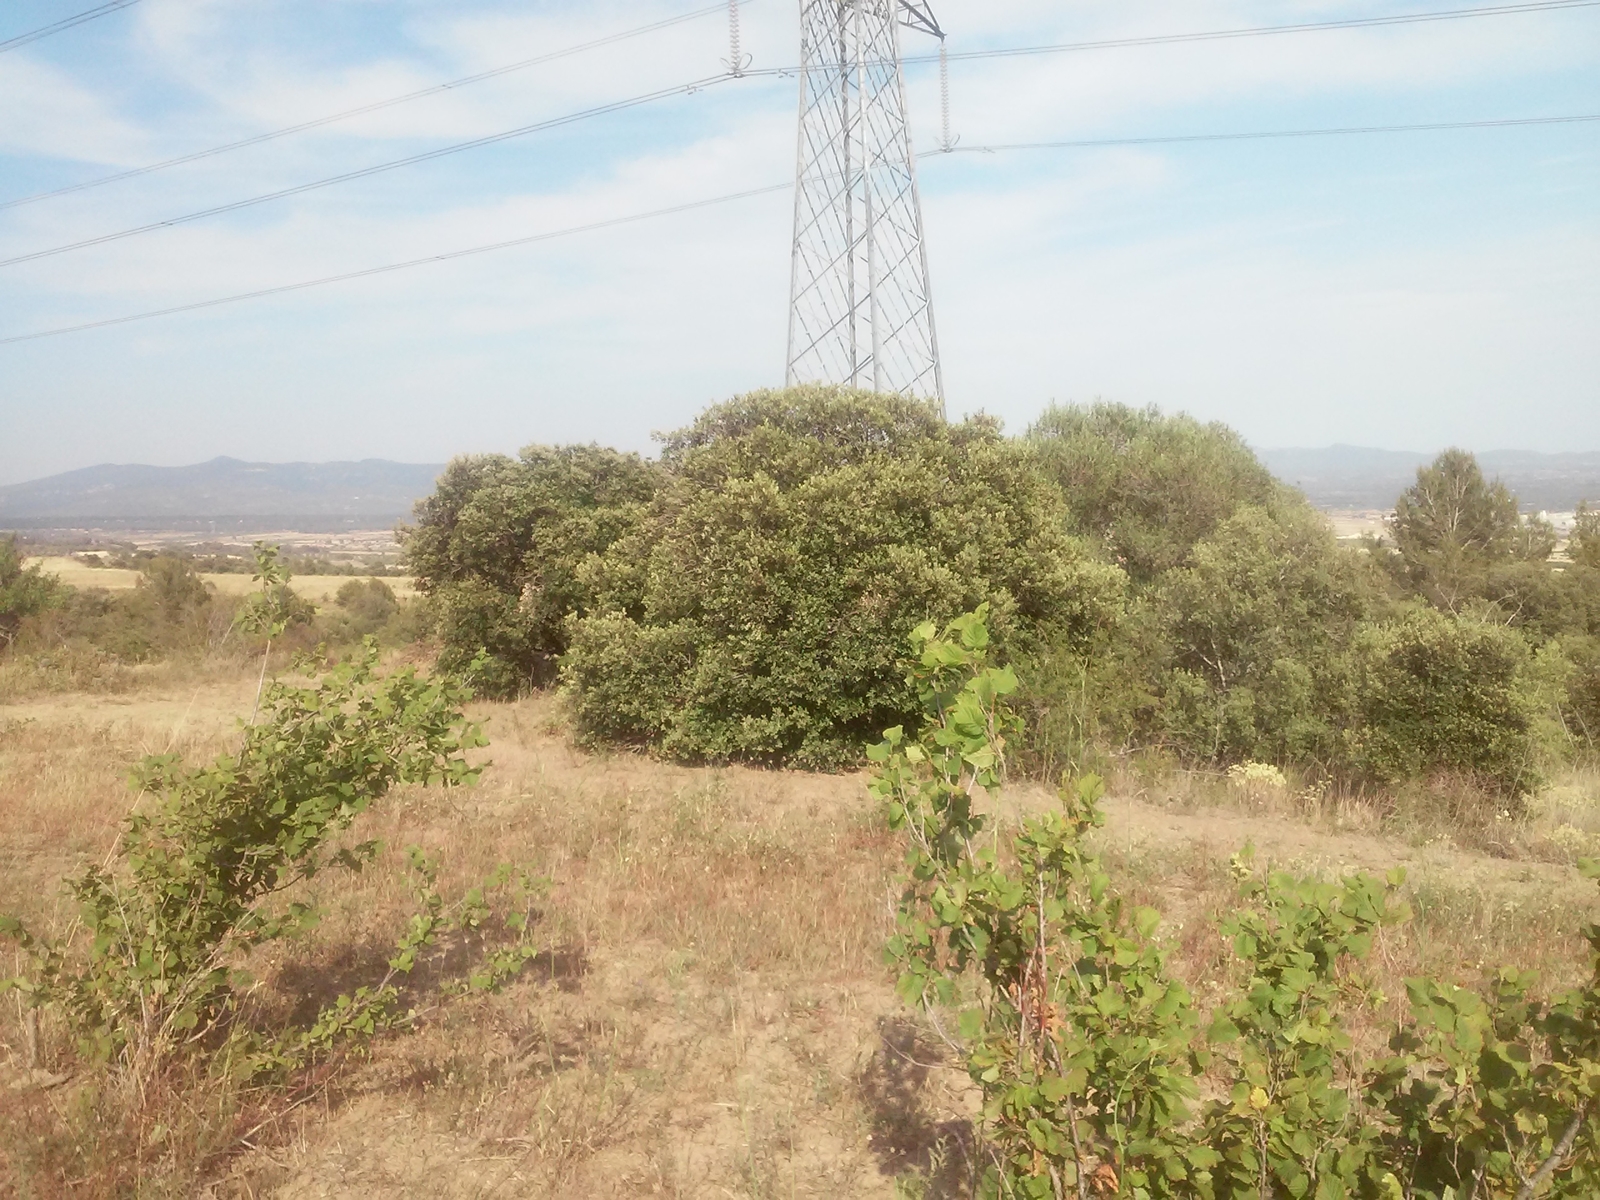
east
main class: Cropland
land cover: Nuts trees
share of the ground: < 10 %
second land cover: Grassland without tree/shrub cover
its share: > 75 %
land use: Agriculture (excluding fallow land and kitchen gardens)
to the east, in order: Nuts trees; Grassland without tree/shrub cover; Broadleaved woodland; Electric lines; Broadleaved woodland
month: June
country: ES
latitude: 41.3668
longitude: 1.2529
